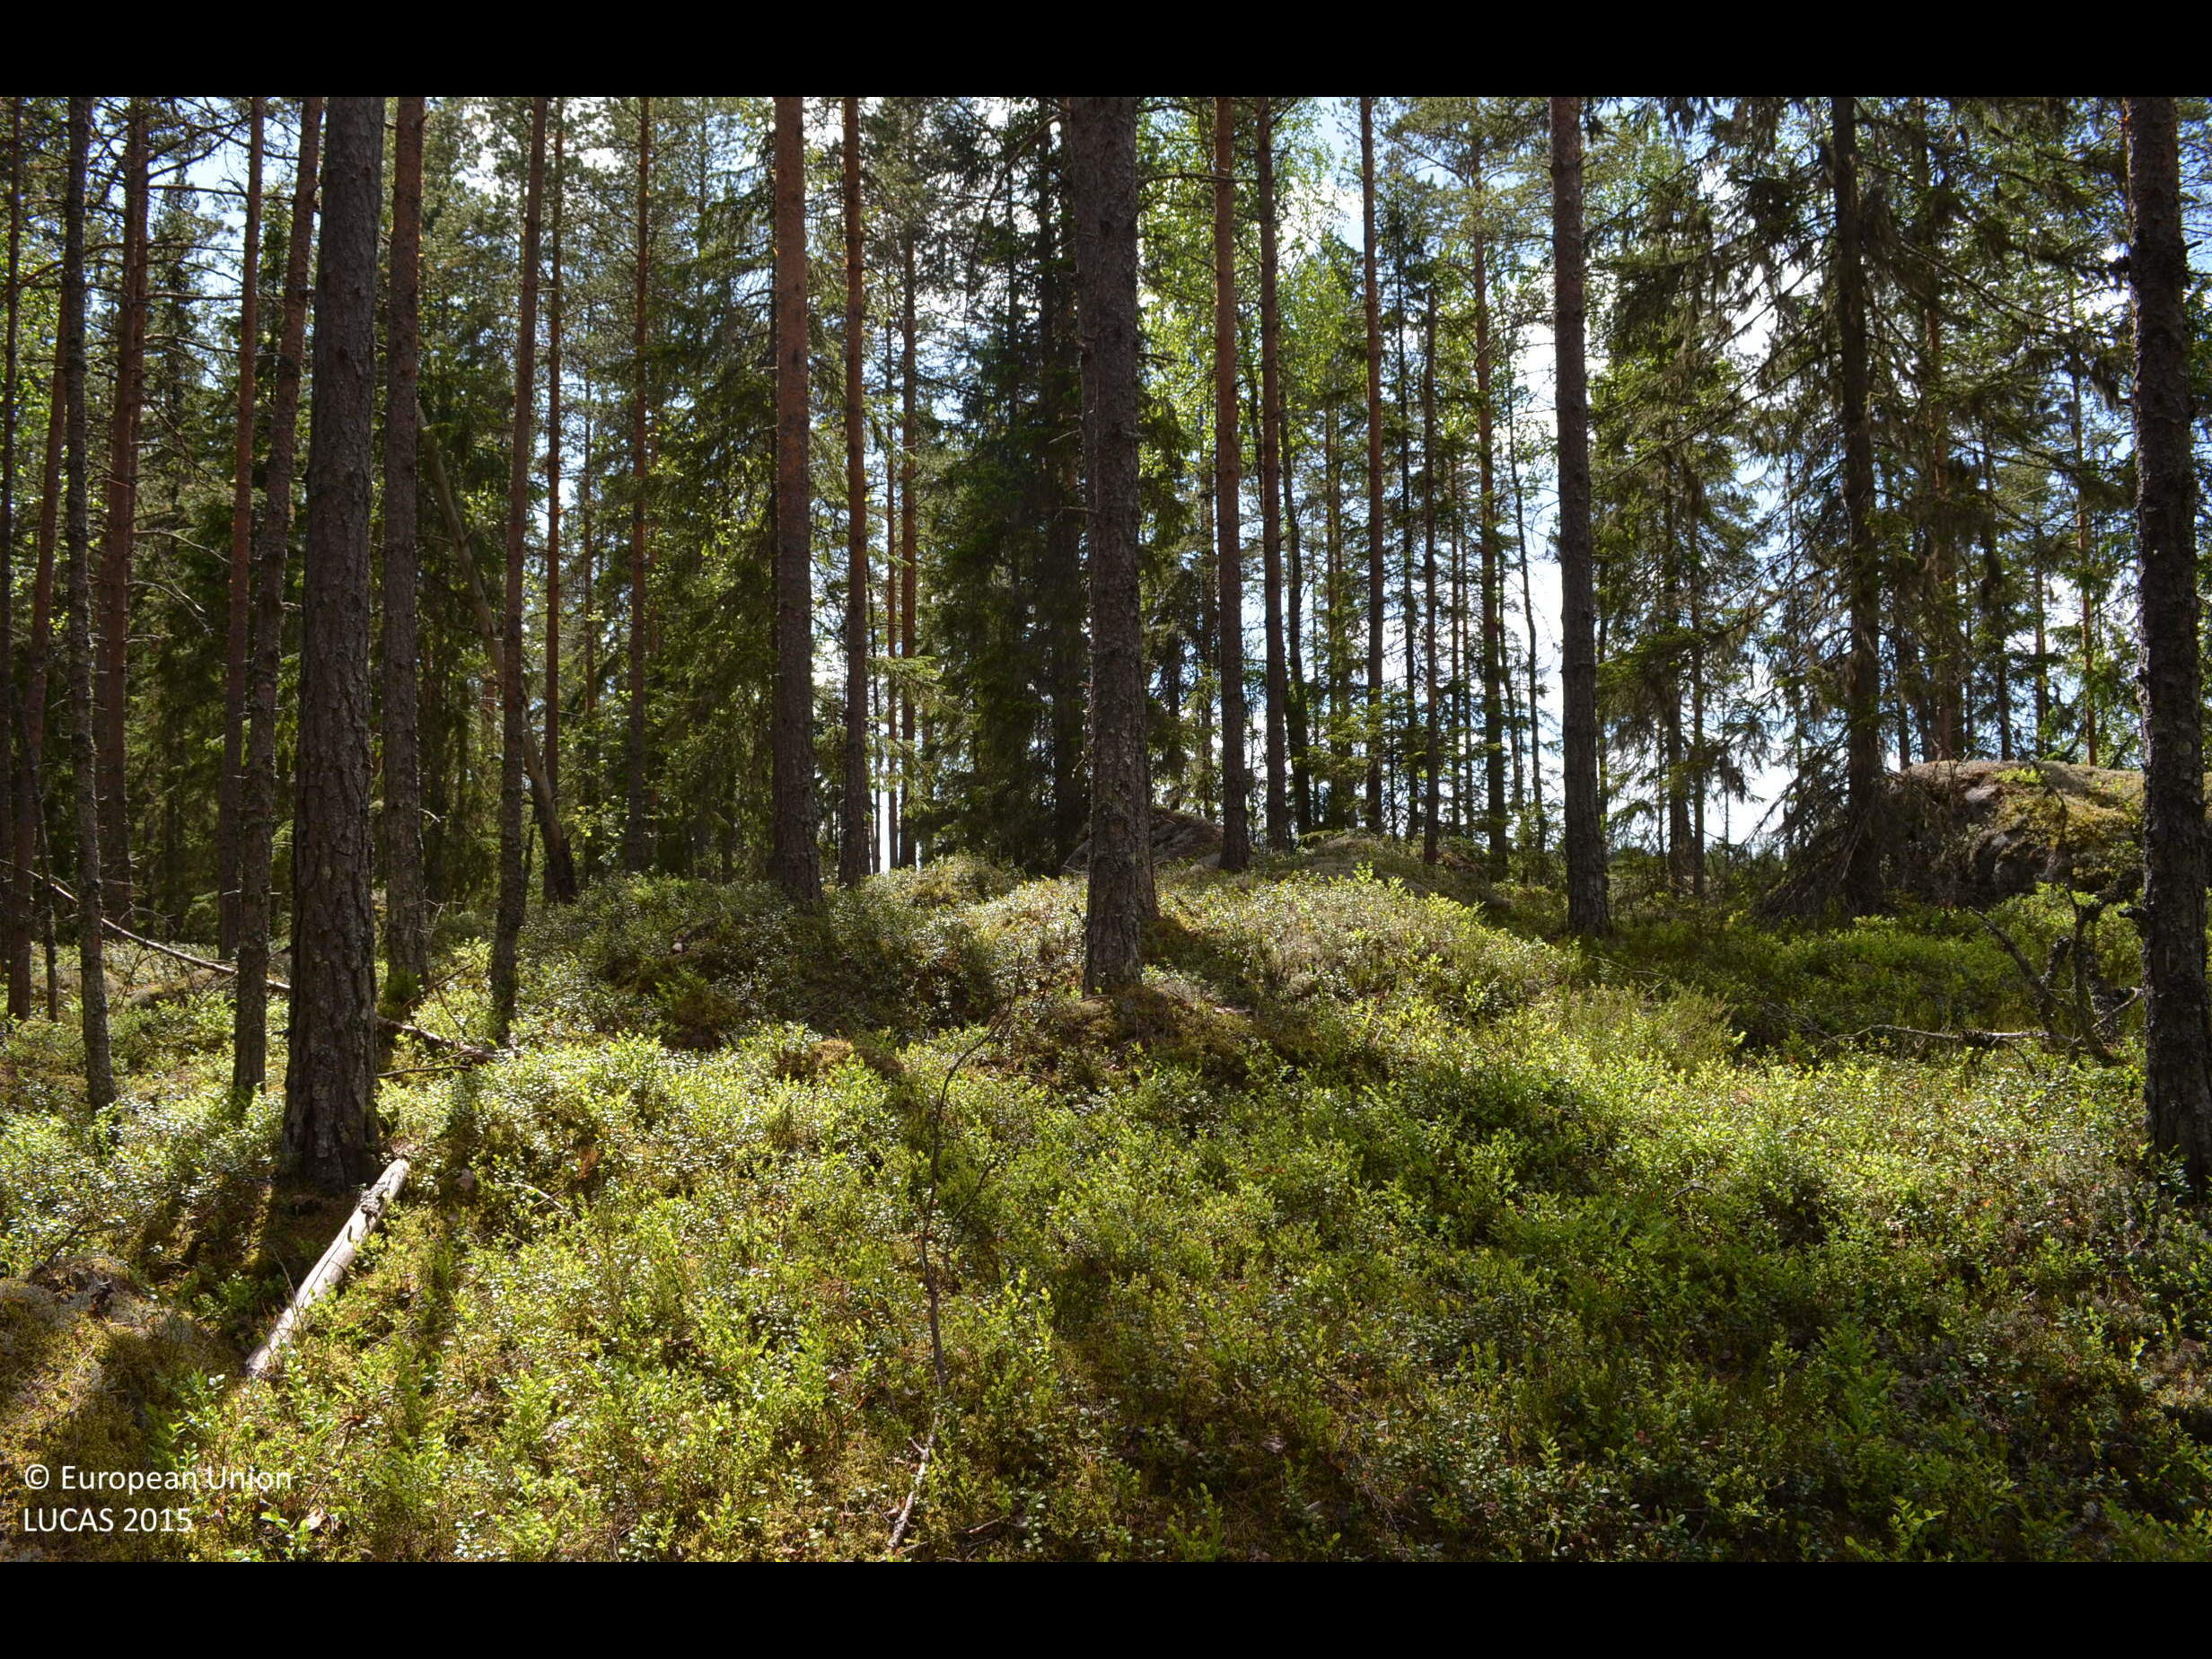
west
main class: Woodland
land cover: Other coniferous woodland
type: boreal forest
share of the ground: 50 - 75 %
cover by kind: coniferous forest trees 70 %, shrubs 25 %, lichens and mosses 5 %
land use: Forestry
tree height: > 5 m
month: June
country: FI
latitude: 61.8062
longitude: 23.2208
